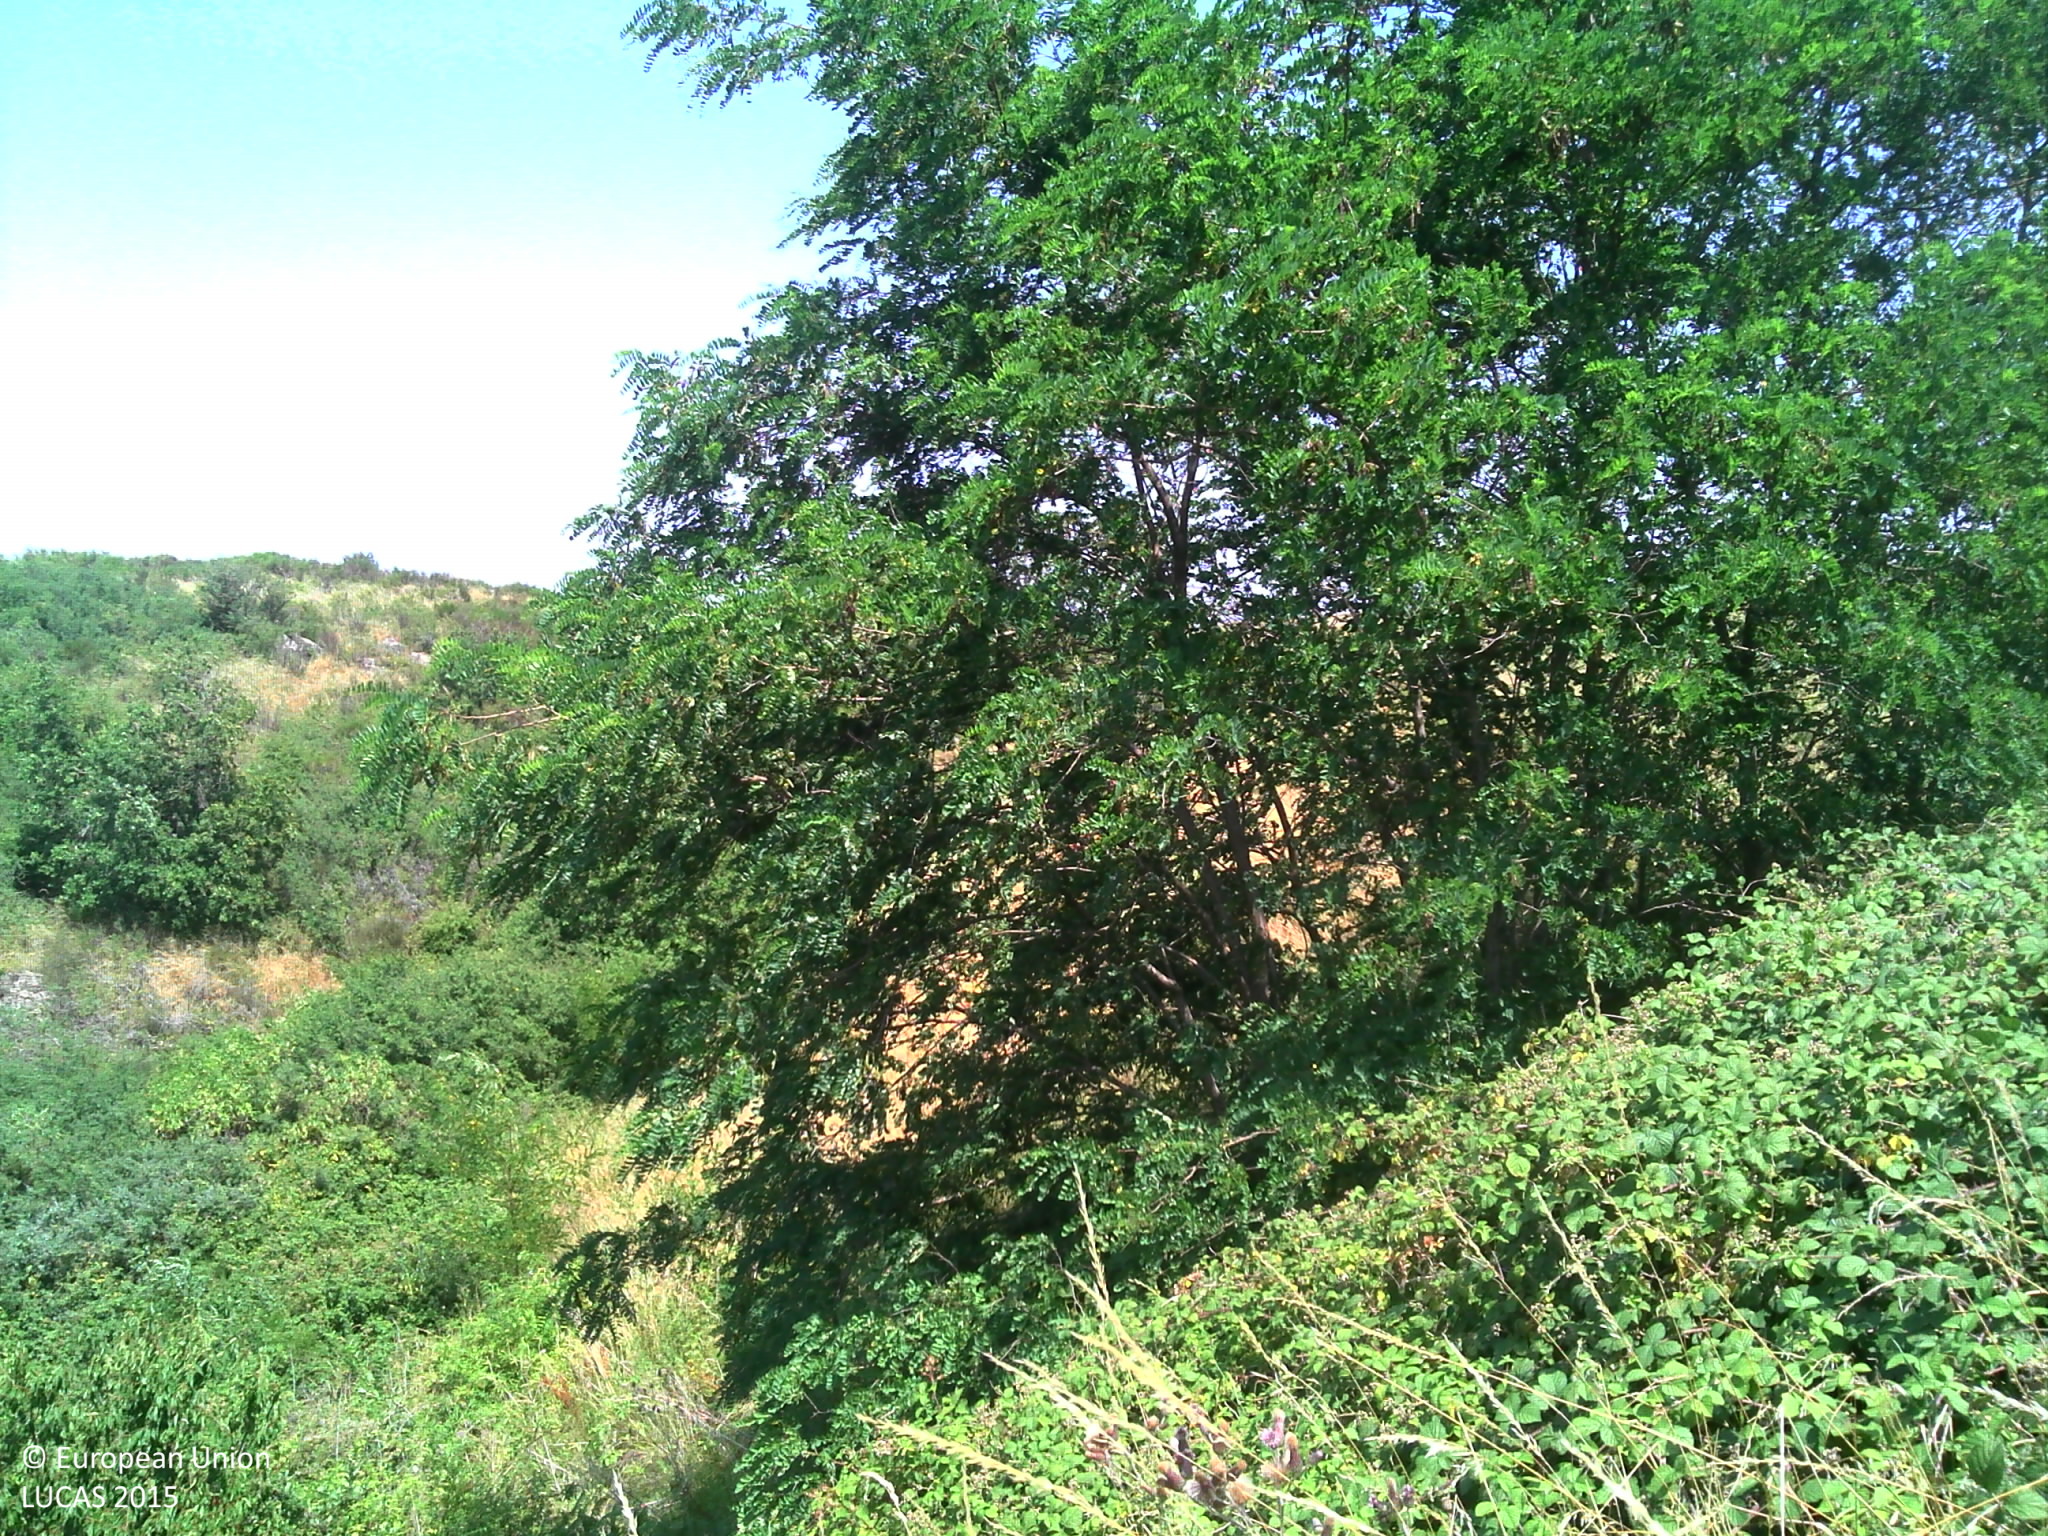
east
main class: Shrubland
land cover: Shrubland with sparse tree cover
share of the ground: > 75 %
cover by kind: shrubs 65 %, herbaceous plants 30 %, broadleaved forest trees 5 %
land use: Semi-natural and natural areas not in use
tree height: < 5 m
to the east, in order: Shrubland with sparse tree cover; Spontaneously vegetated surfaces; Fences; Spontaneously vegetated surfaces; Fences; Spontaneously vegetated surfaces; Grass margins; Grassland without tree/shrub cover; Shrubland without tree cover; Shrubland with sparse tree cover
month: July
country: FR
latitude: 43.4442
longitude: 2.0114
